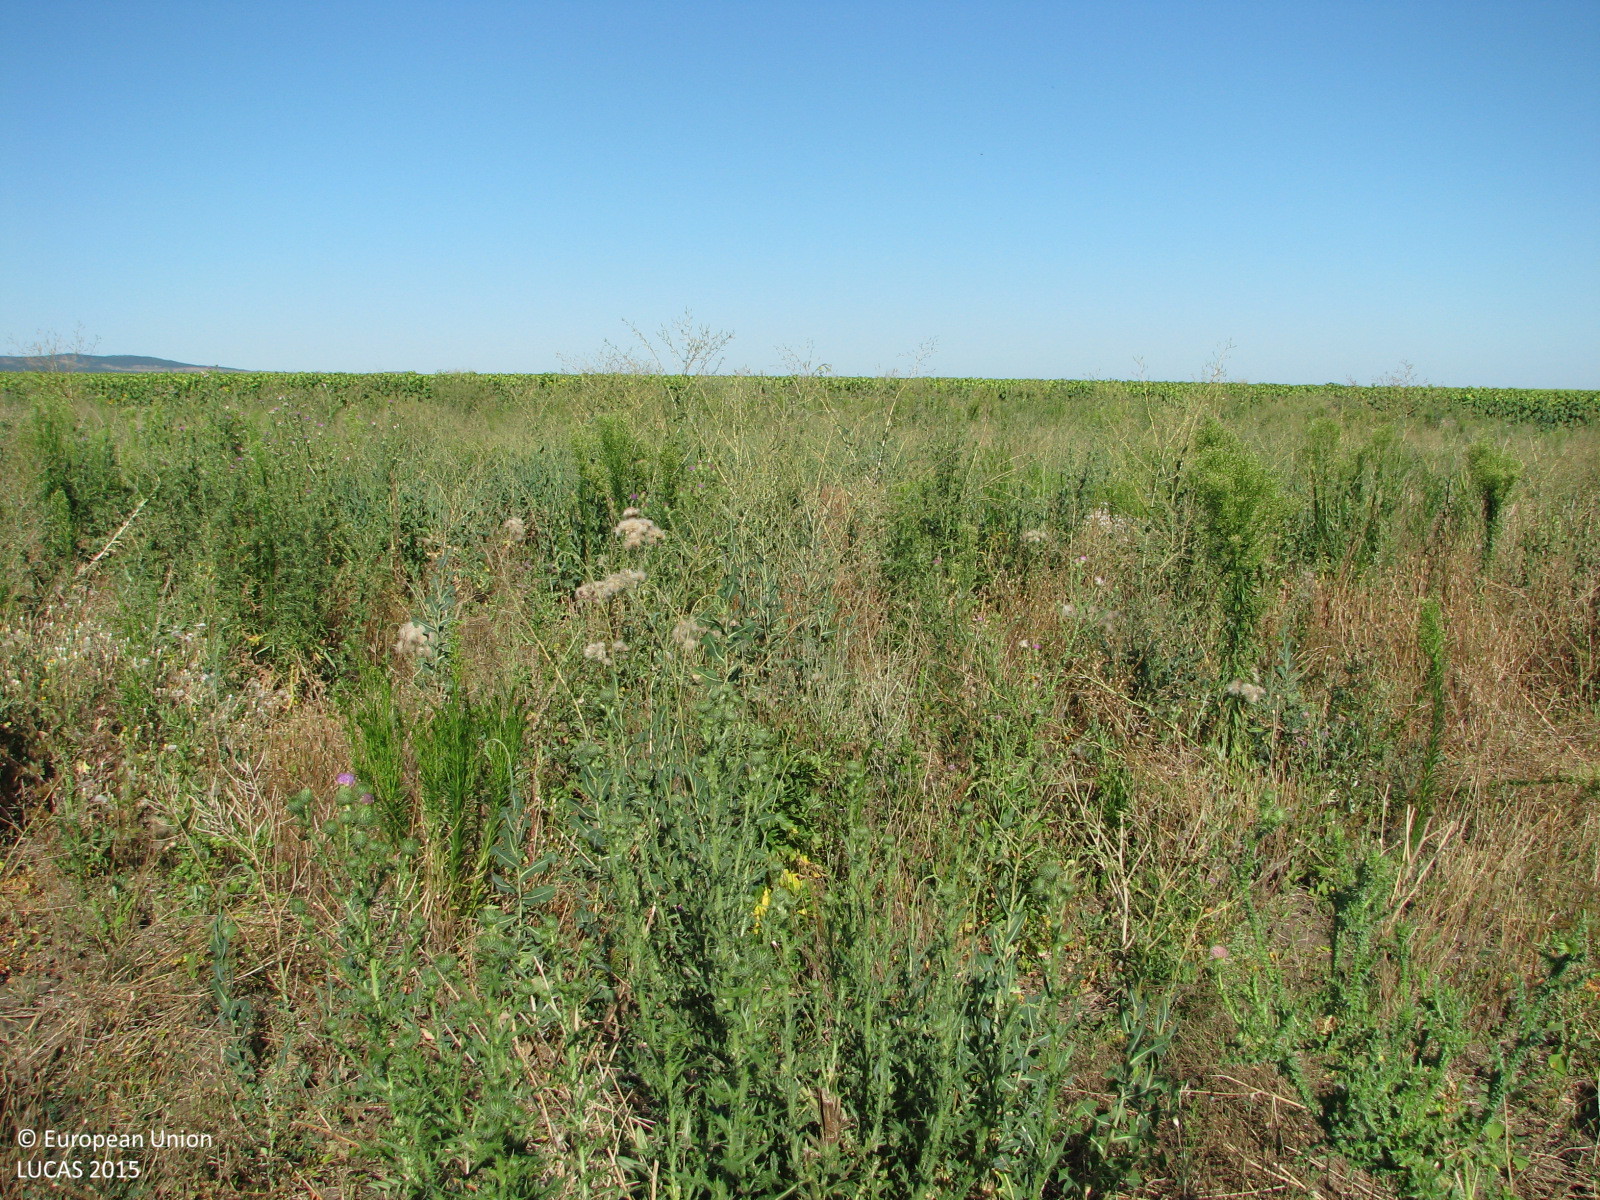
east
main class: Grassland
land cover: Spontaneously vegetated surfaces
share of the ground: > 75 %
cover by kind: herbaceous plants 100 %
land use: Fallow land
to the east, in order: Spontaneously vegetated surfaces; Sunflower; Grass margins; Common wheat
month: July
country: BG
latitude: 42.3788
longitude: 26.0264
